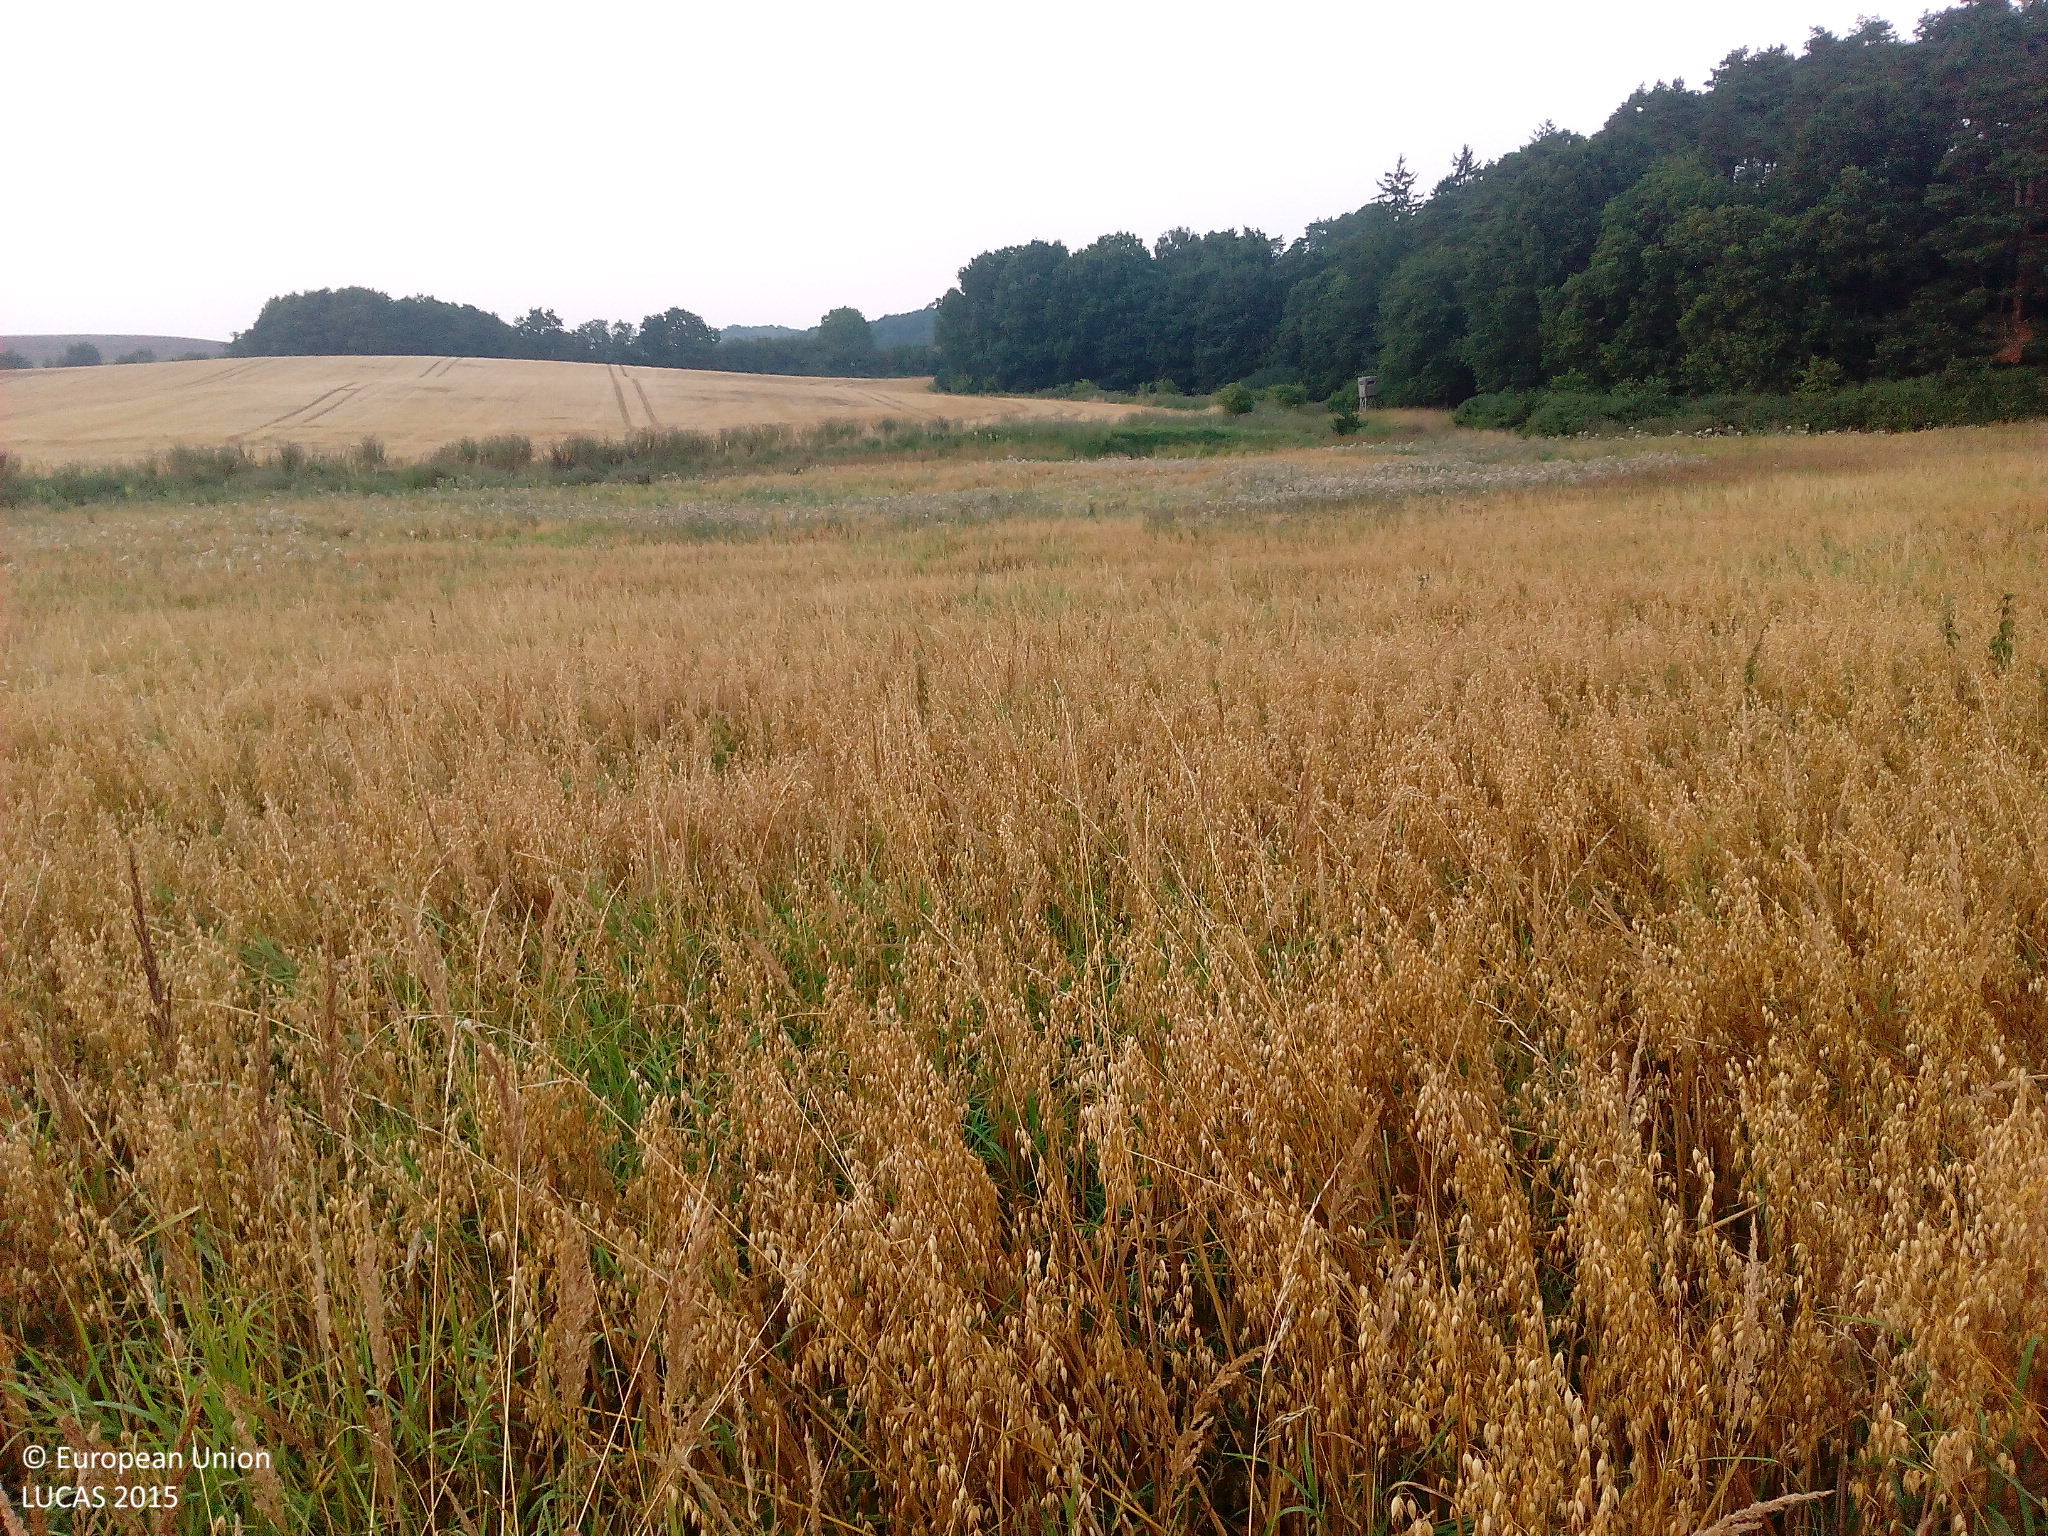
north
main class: Cropland
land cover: Oats
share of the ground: > 75 %
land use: Agriculture (excluding fallow land and kitchen gardens)
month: August
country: DE
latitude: 53.7214
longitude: 12.3178
